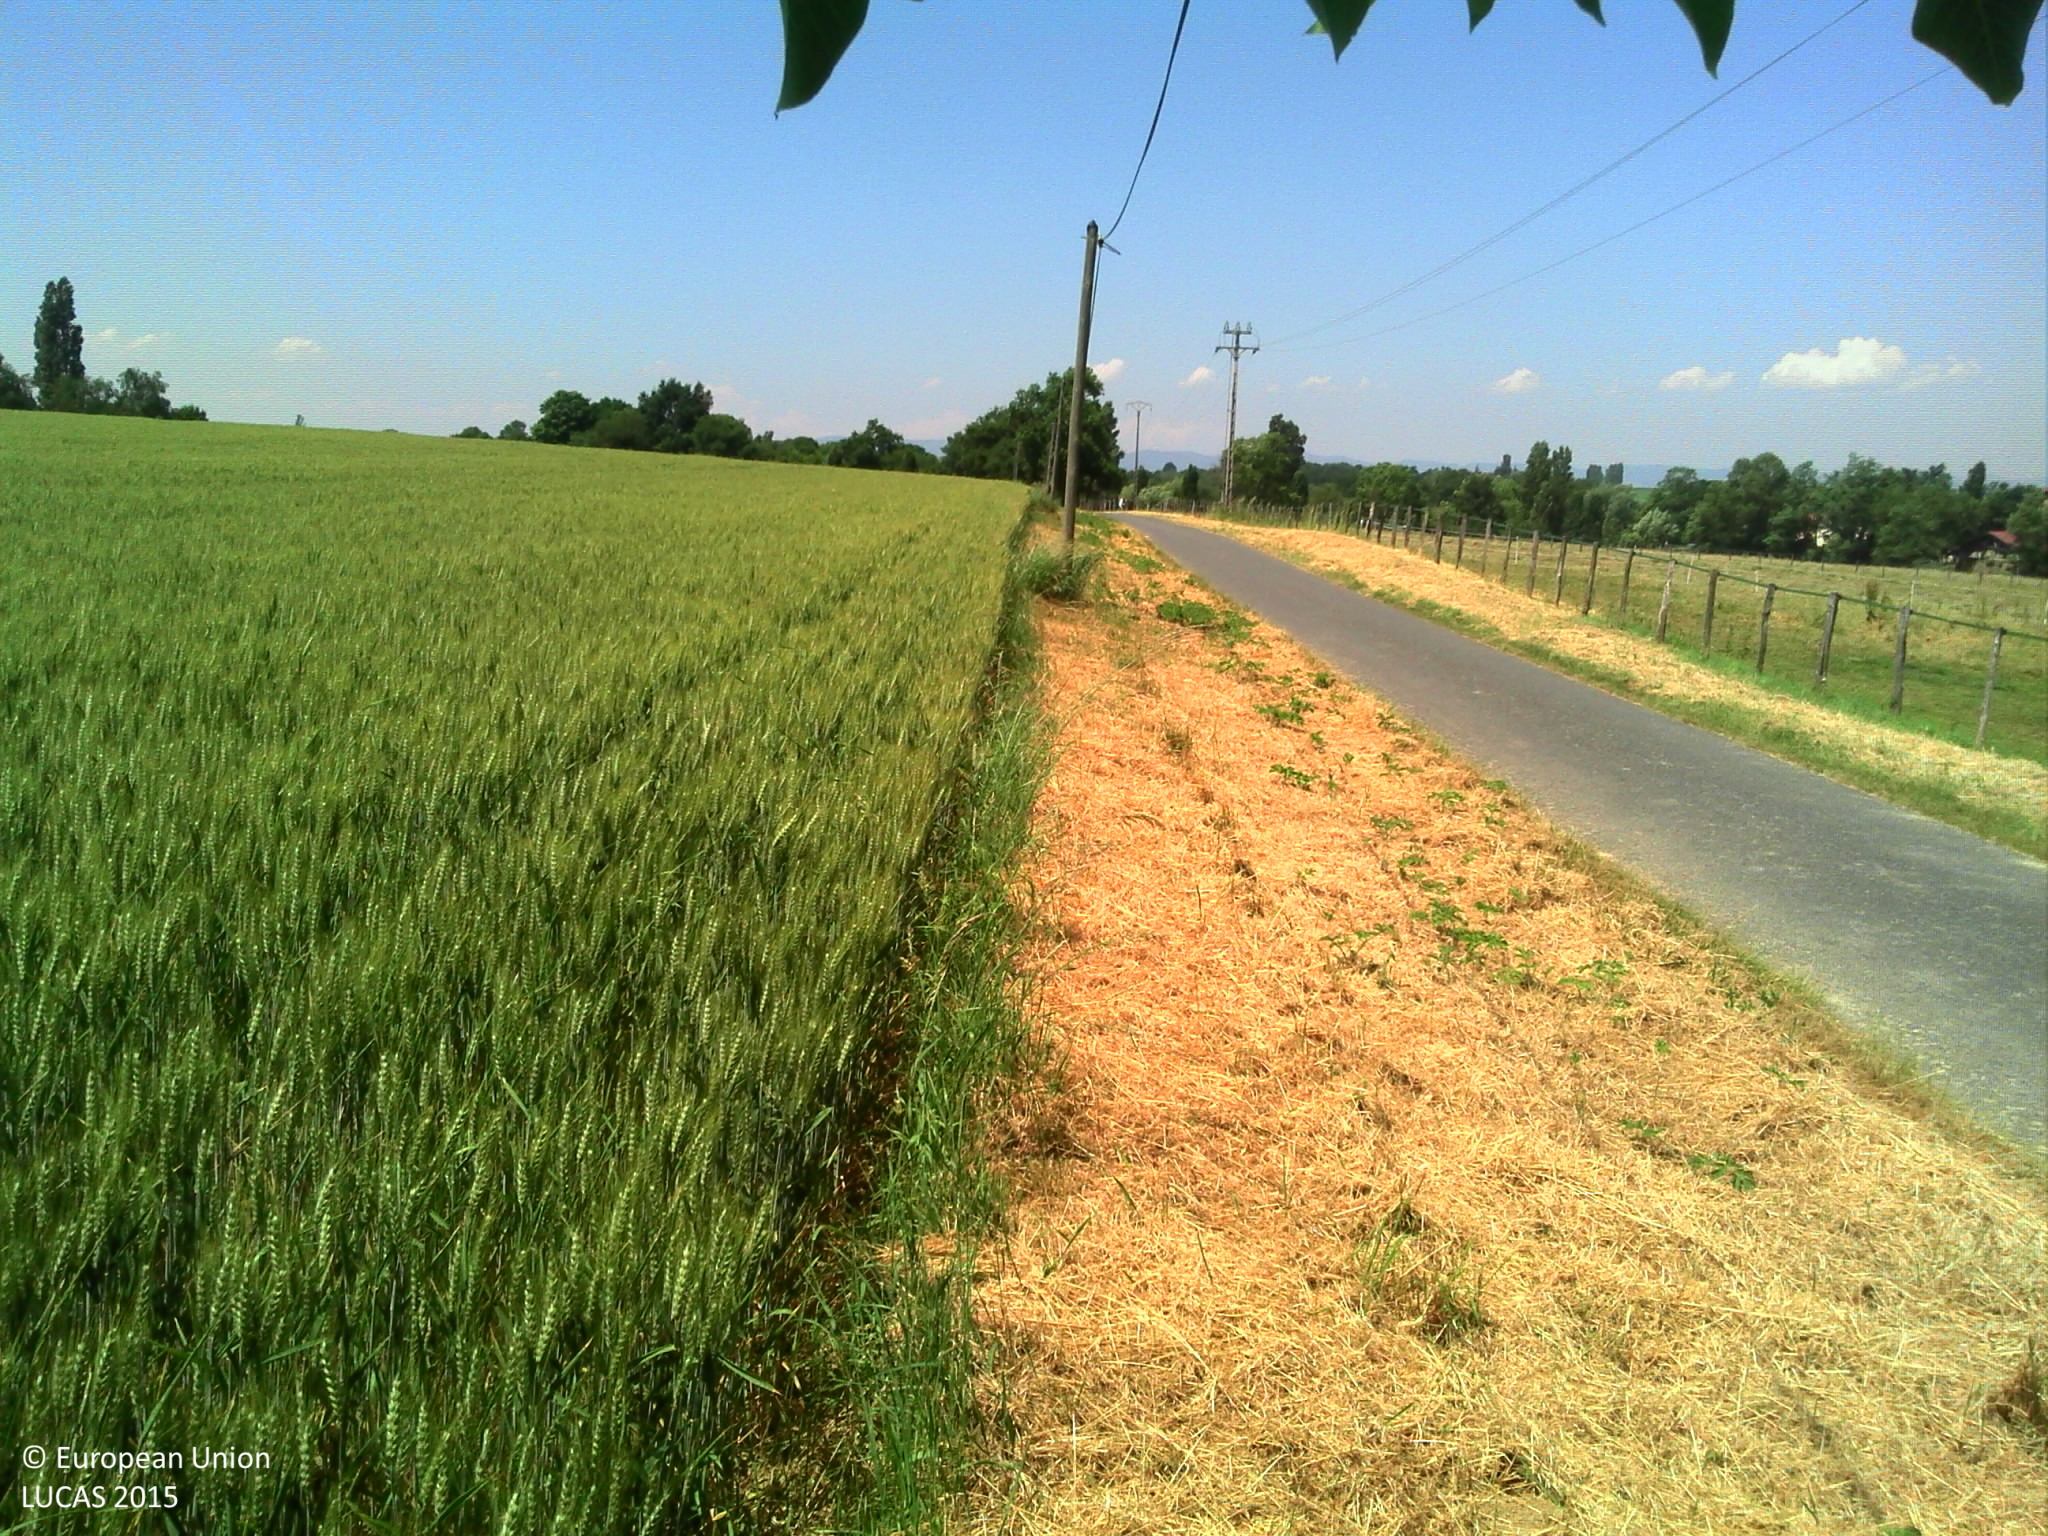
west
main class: Cropland
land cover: Durum wheat
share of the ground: > 75 %
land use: Agriculture (excluding fallow land and kitchen gardens)
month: June
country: FR
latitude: 45.9926
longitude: 4.8517
